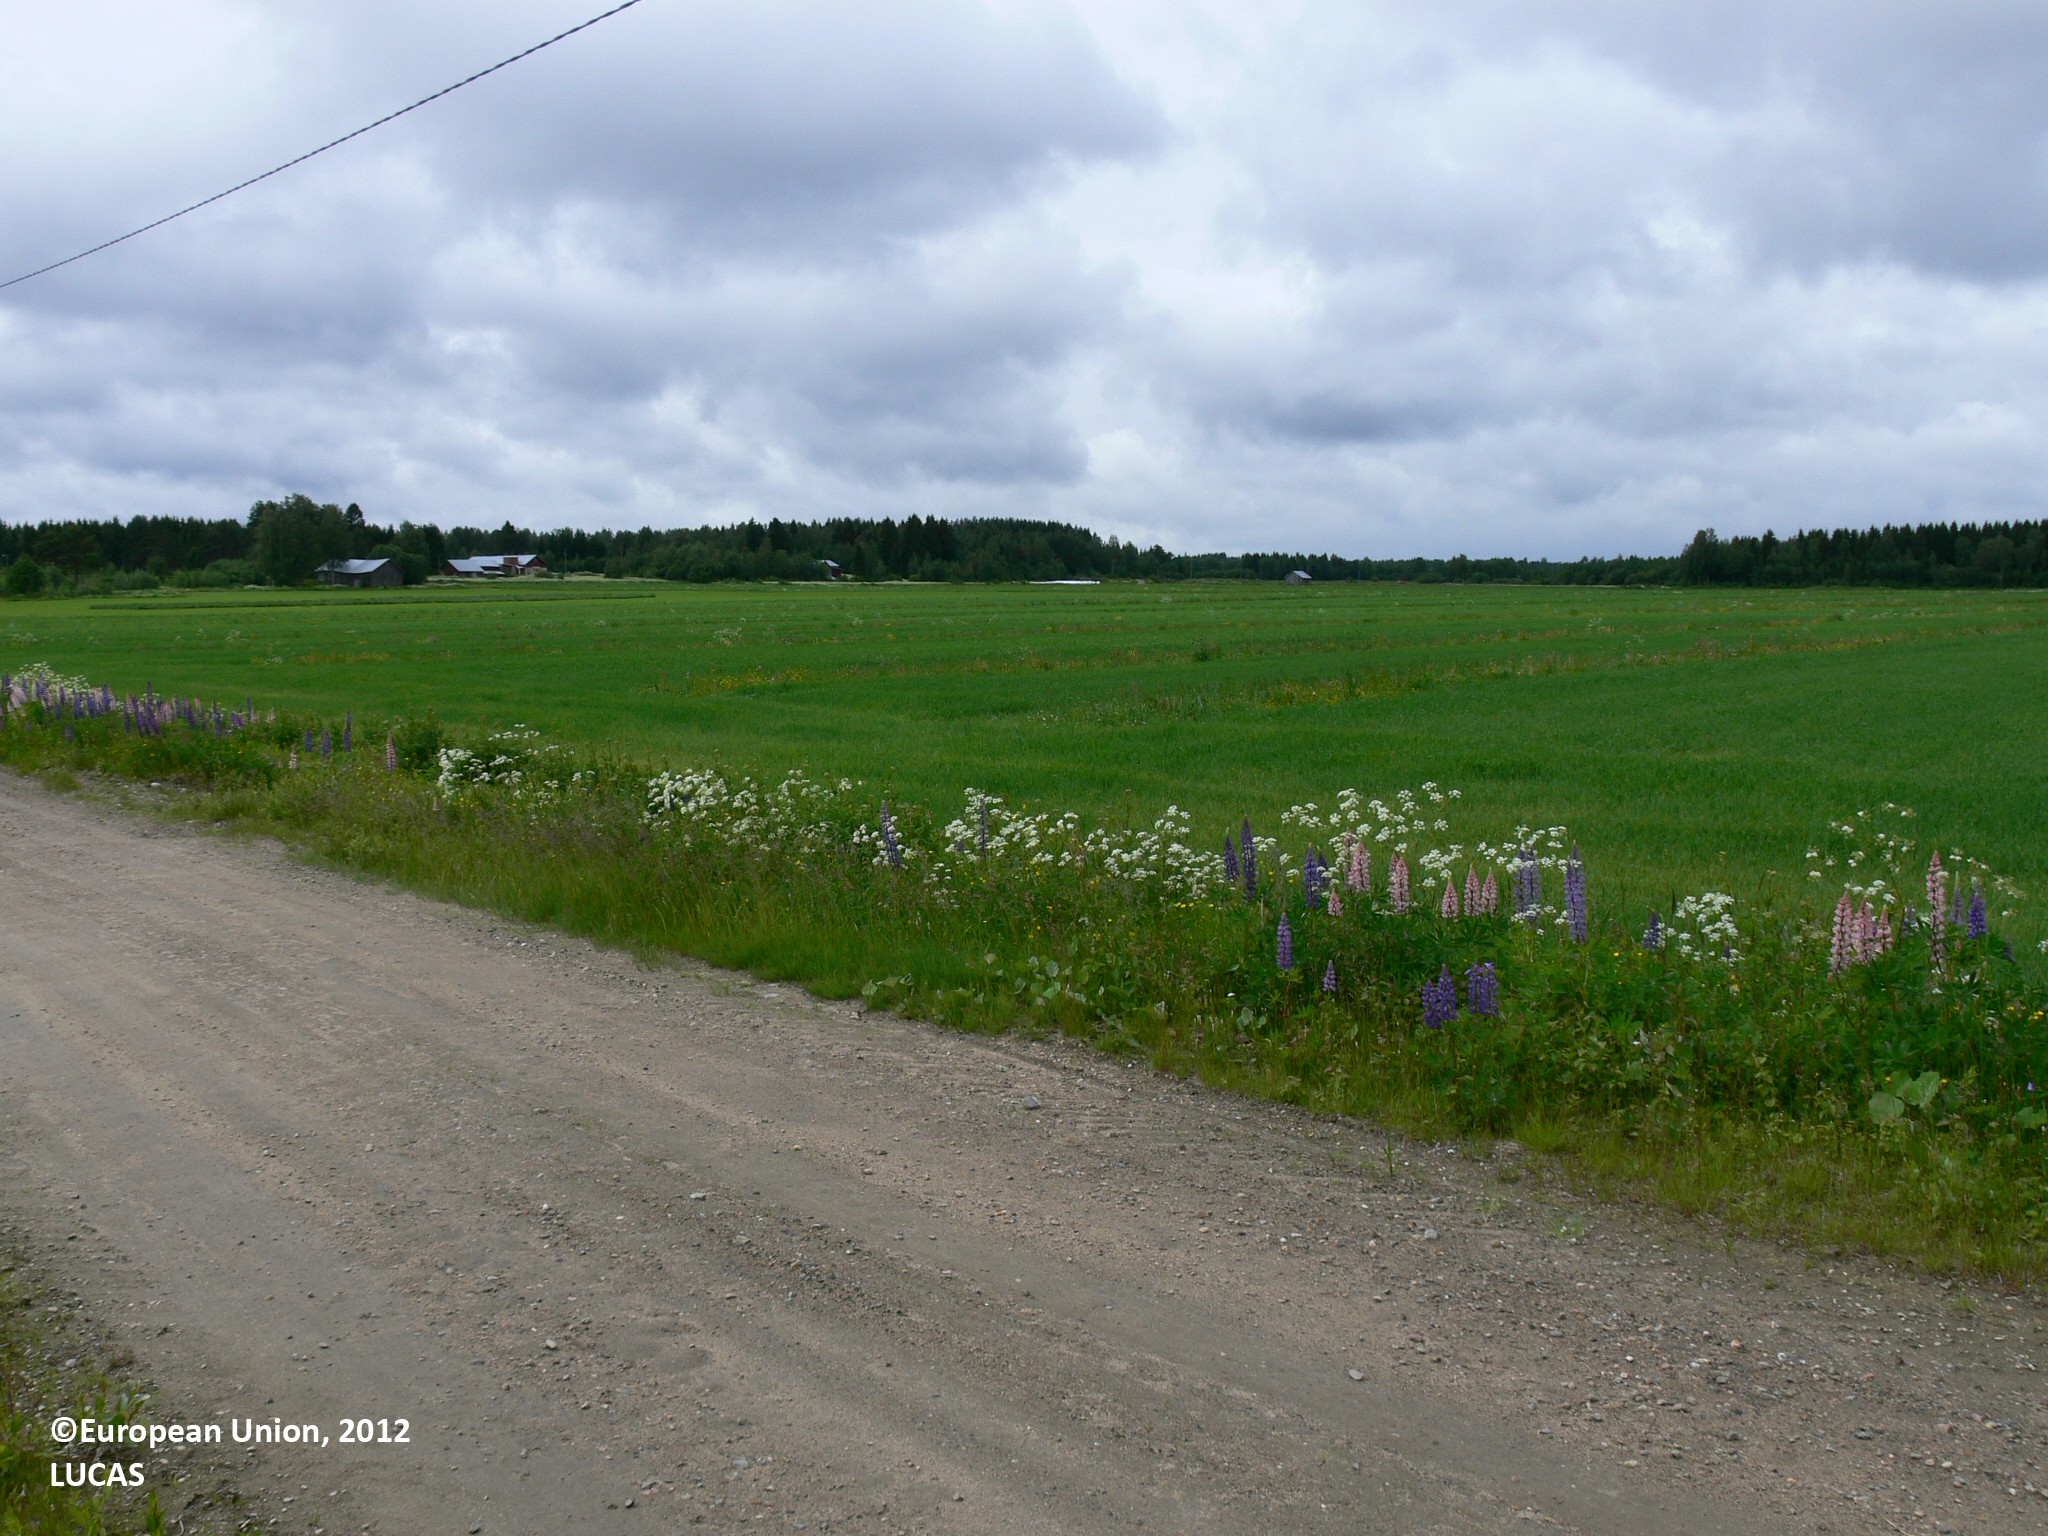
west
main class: Cropland
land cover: Barley
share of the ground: > 75 %
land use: Agriculture (excluding fallow land and kitchen gardens)
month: June
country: FI
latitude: 62.8216
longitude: 29.2819
